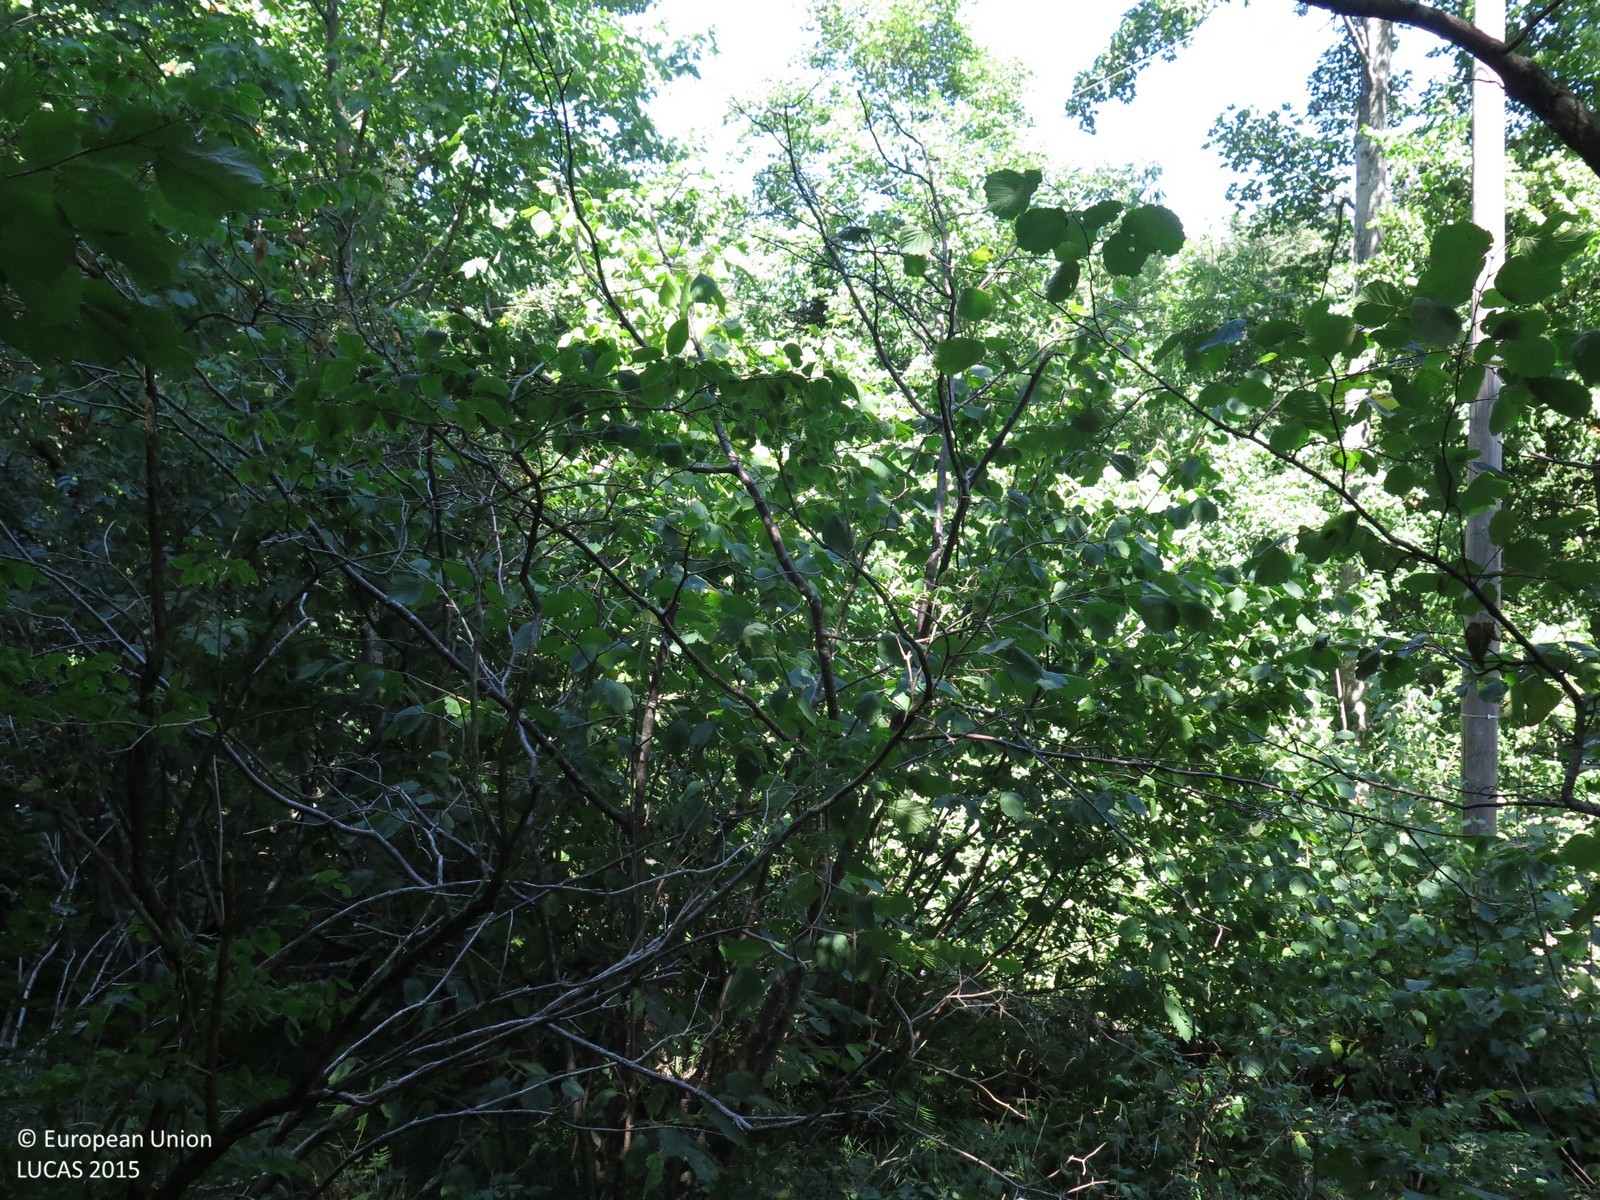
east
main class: Woodland
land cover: Other mixed woodland
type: mountainous beech forest
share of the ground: > 75 %
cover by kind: coniferous forest trees 75 %, broadleaved forest trees 25 %
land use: Forestry
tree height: > 5 m
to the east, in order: Other mixed woodland
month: August
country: HR
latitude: 45.1970
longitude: 14.7938
